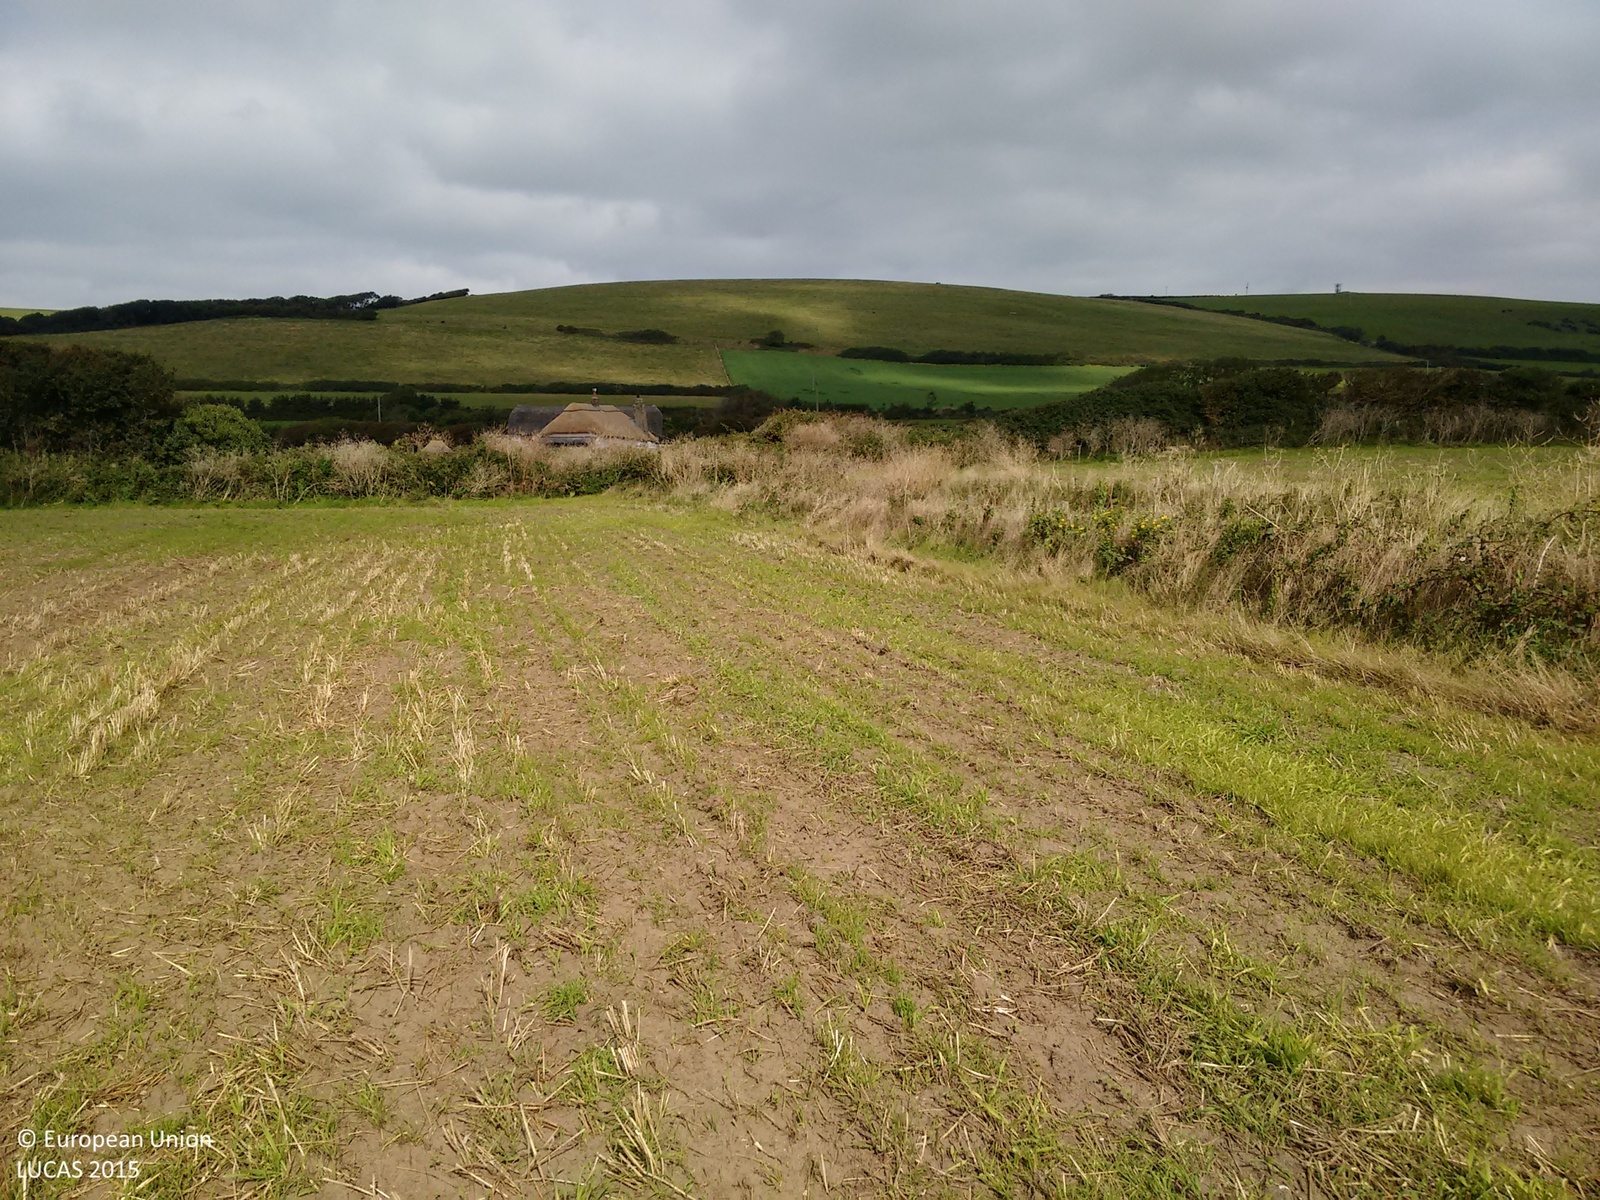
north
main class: Cropland
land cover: Barley
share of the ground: > 75 %
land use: Agriculture (excluding fallow land and kitchen gardens)
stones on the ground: < 10 %
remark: Harvested field
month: September
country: GB
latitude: 51.1163
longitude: -4.1983
